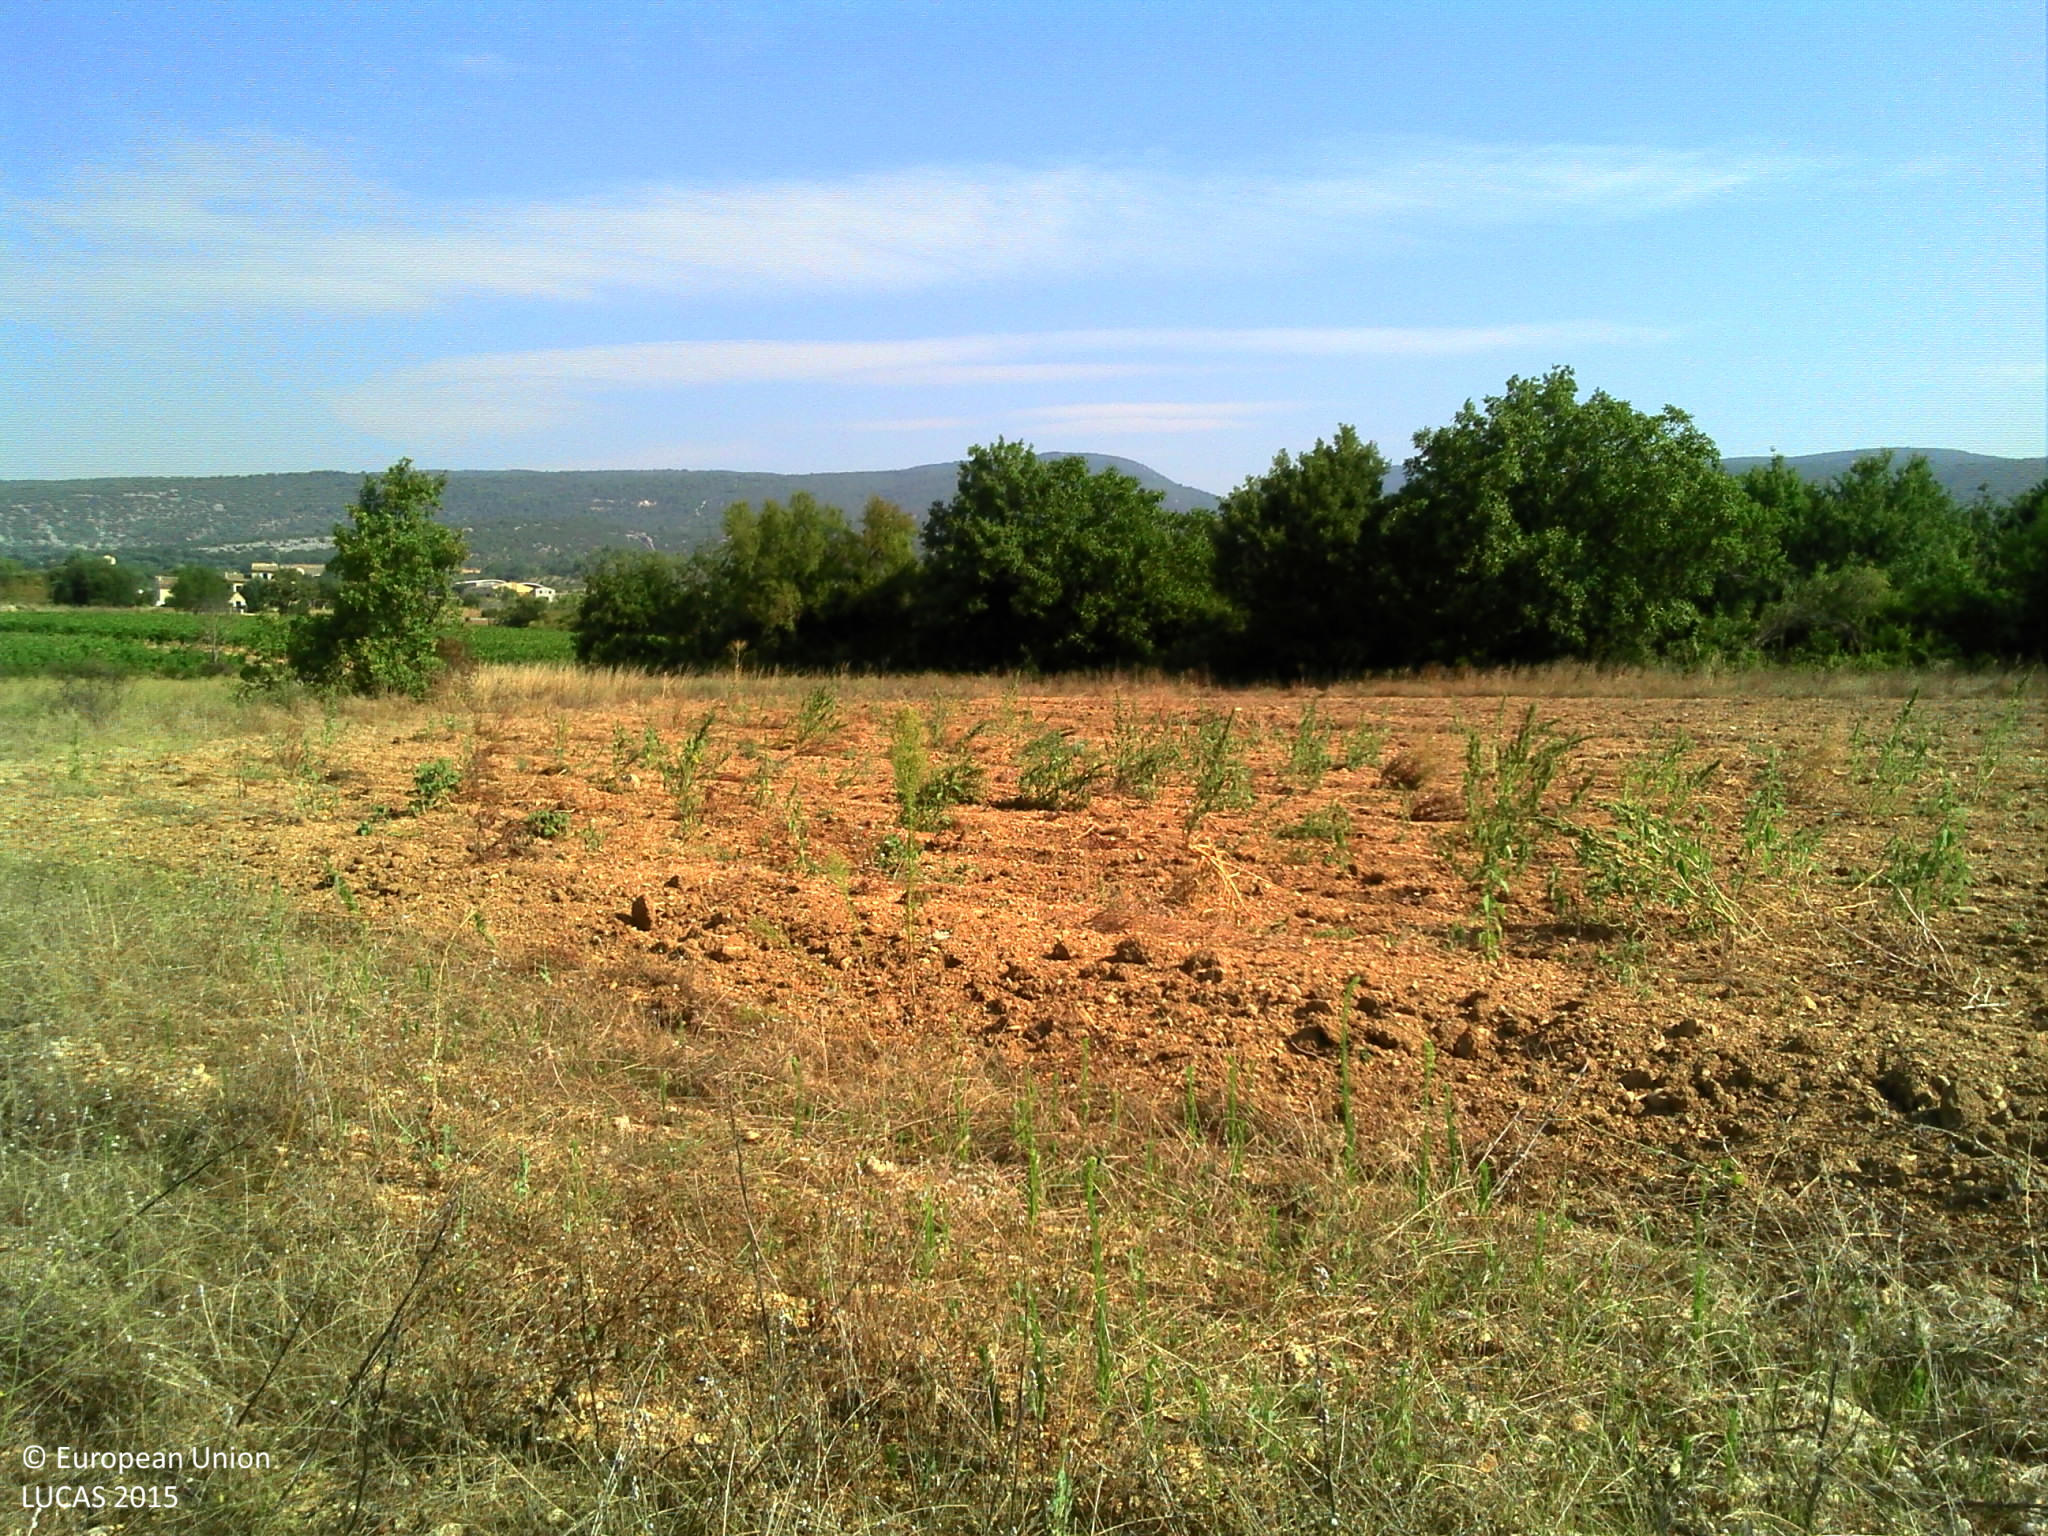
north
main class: Grassland
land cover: Spontaneously vegetated surfaces
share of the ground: > 75 %
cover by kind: herbaceous plants 70 %, unconsolidated bare surface 30 %
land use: Semi-natural and natural areas not in use
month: August
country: FR
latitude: 43.9240
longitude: 5.4127
